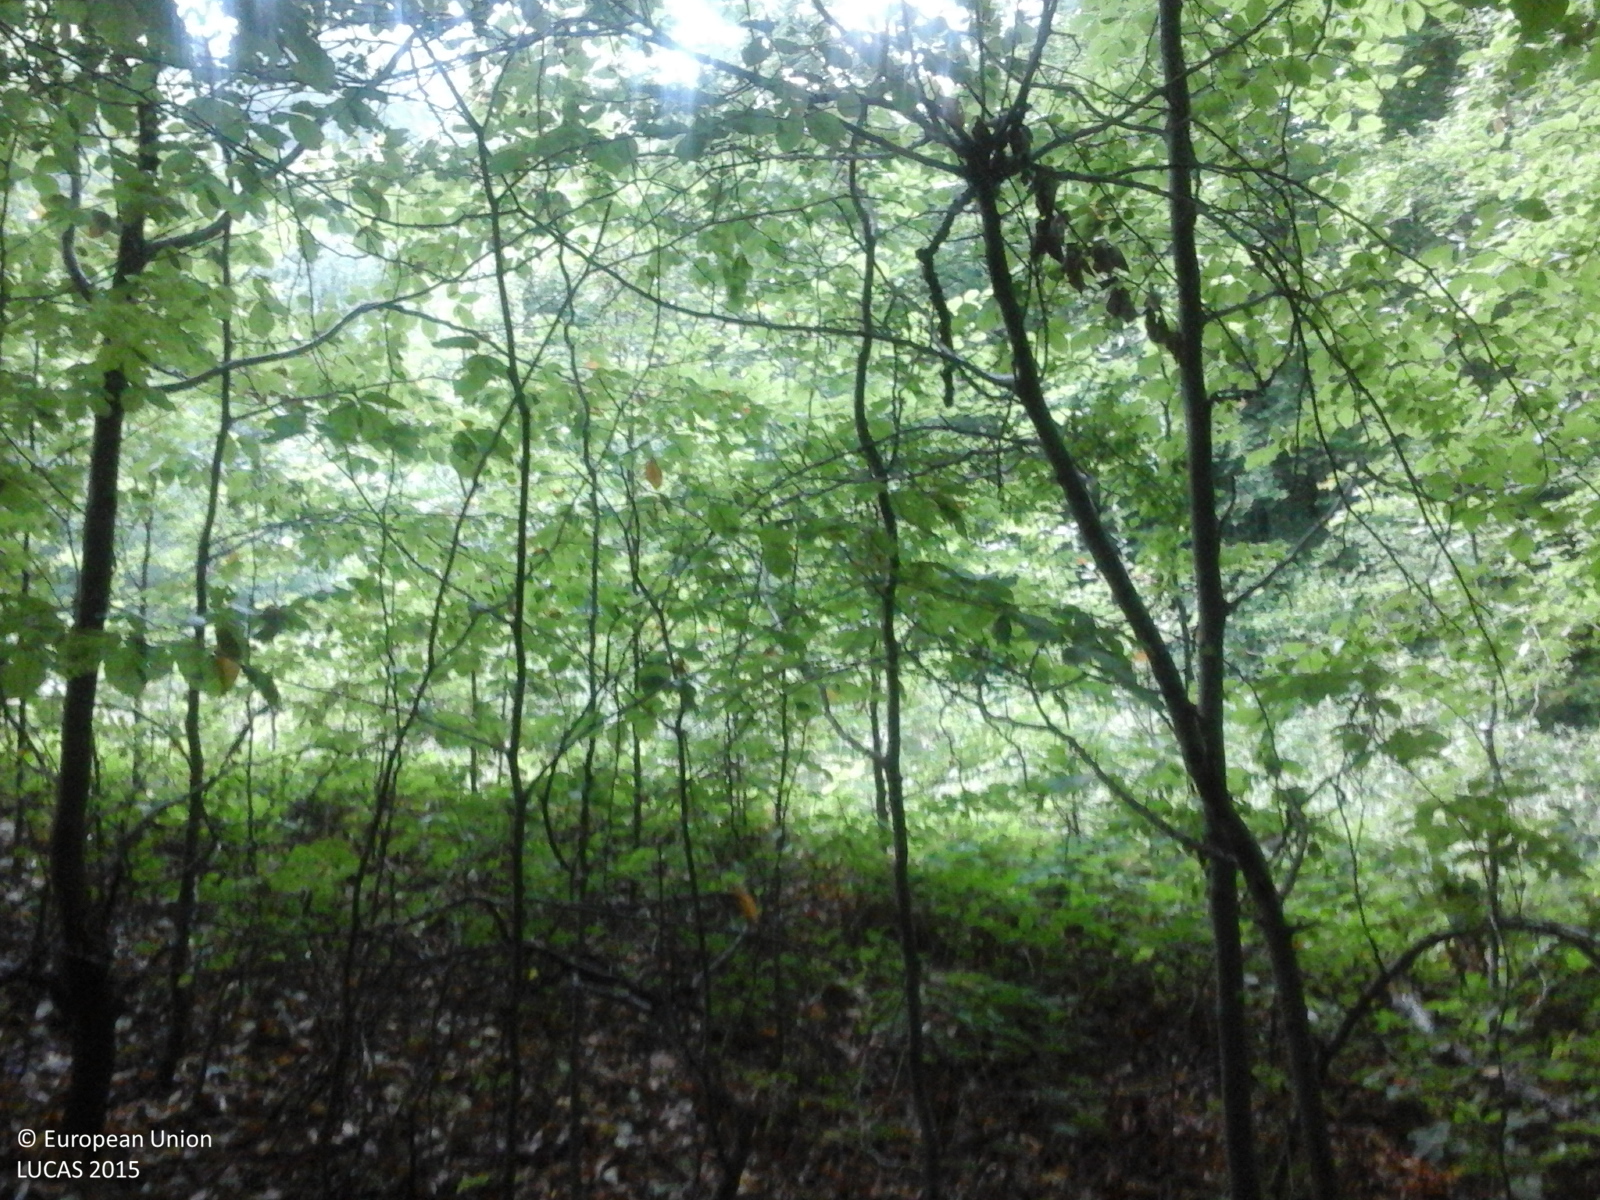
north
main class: Woodland
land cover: Broadleaved woodland
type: beech forest
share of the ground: > 75 %
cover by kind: broadleaved forest trees 100 %
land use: Forestry
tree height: > 5 m
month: August
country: RO
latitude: 44.7857
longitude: 21.7981
